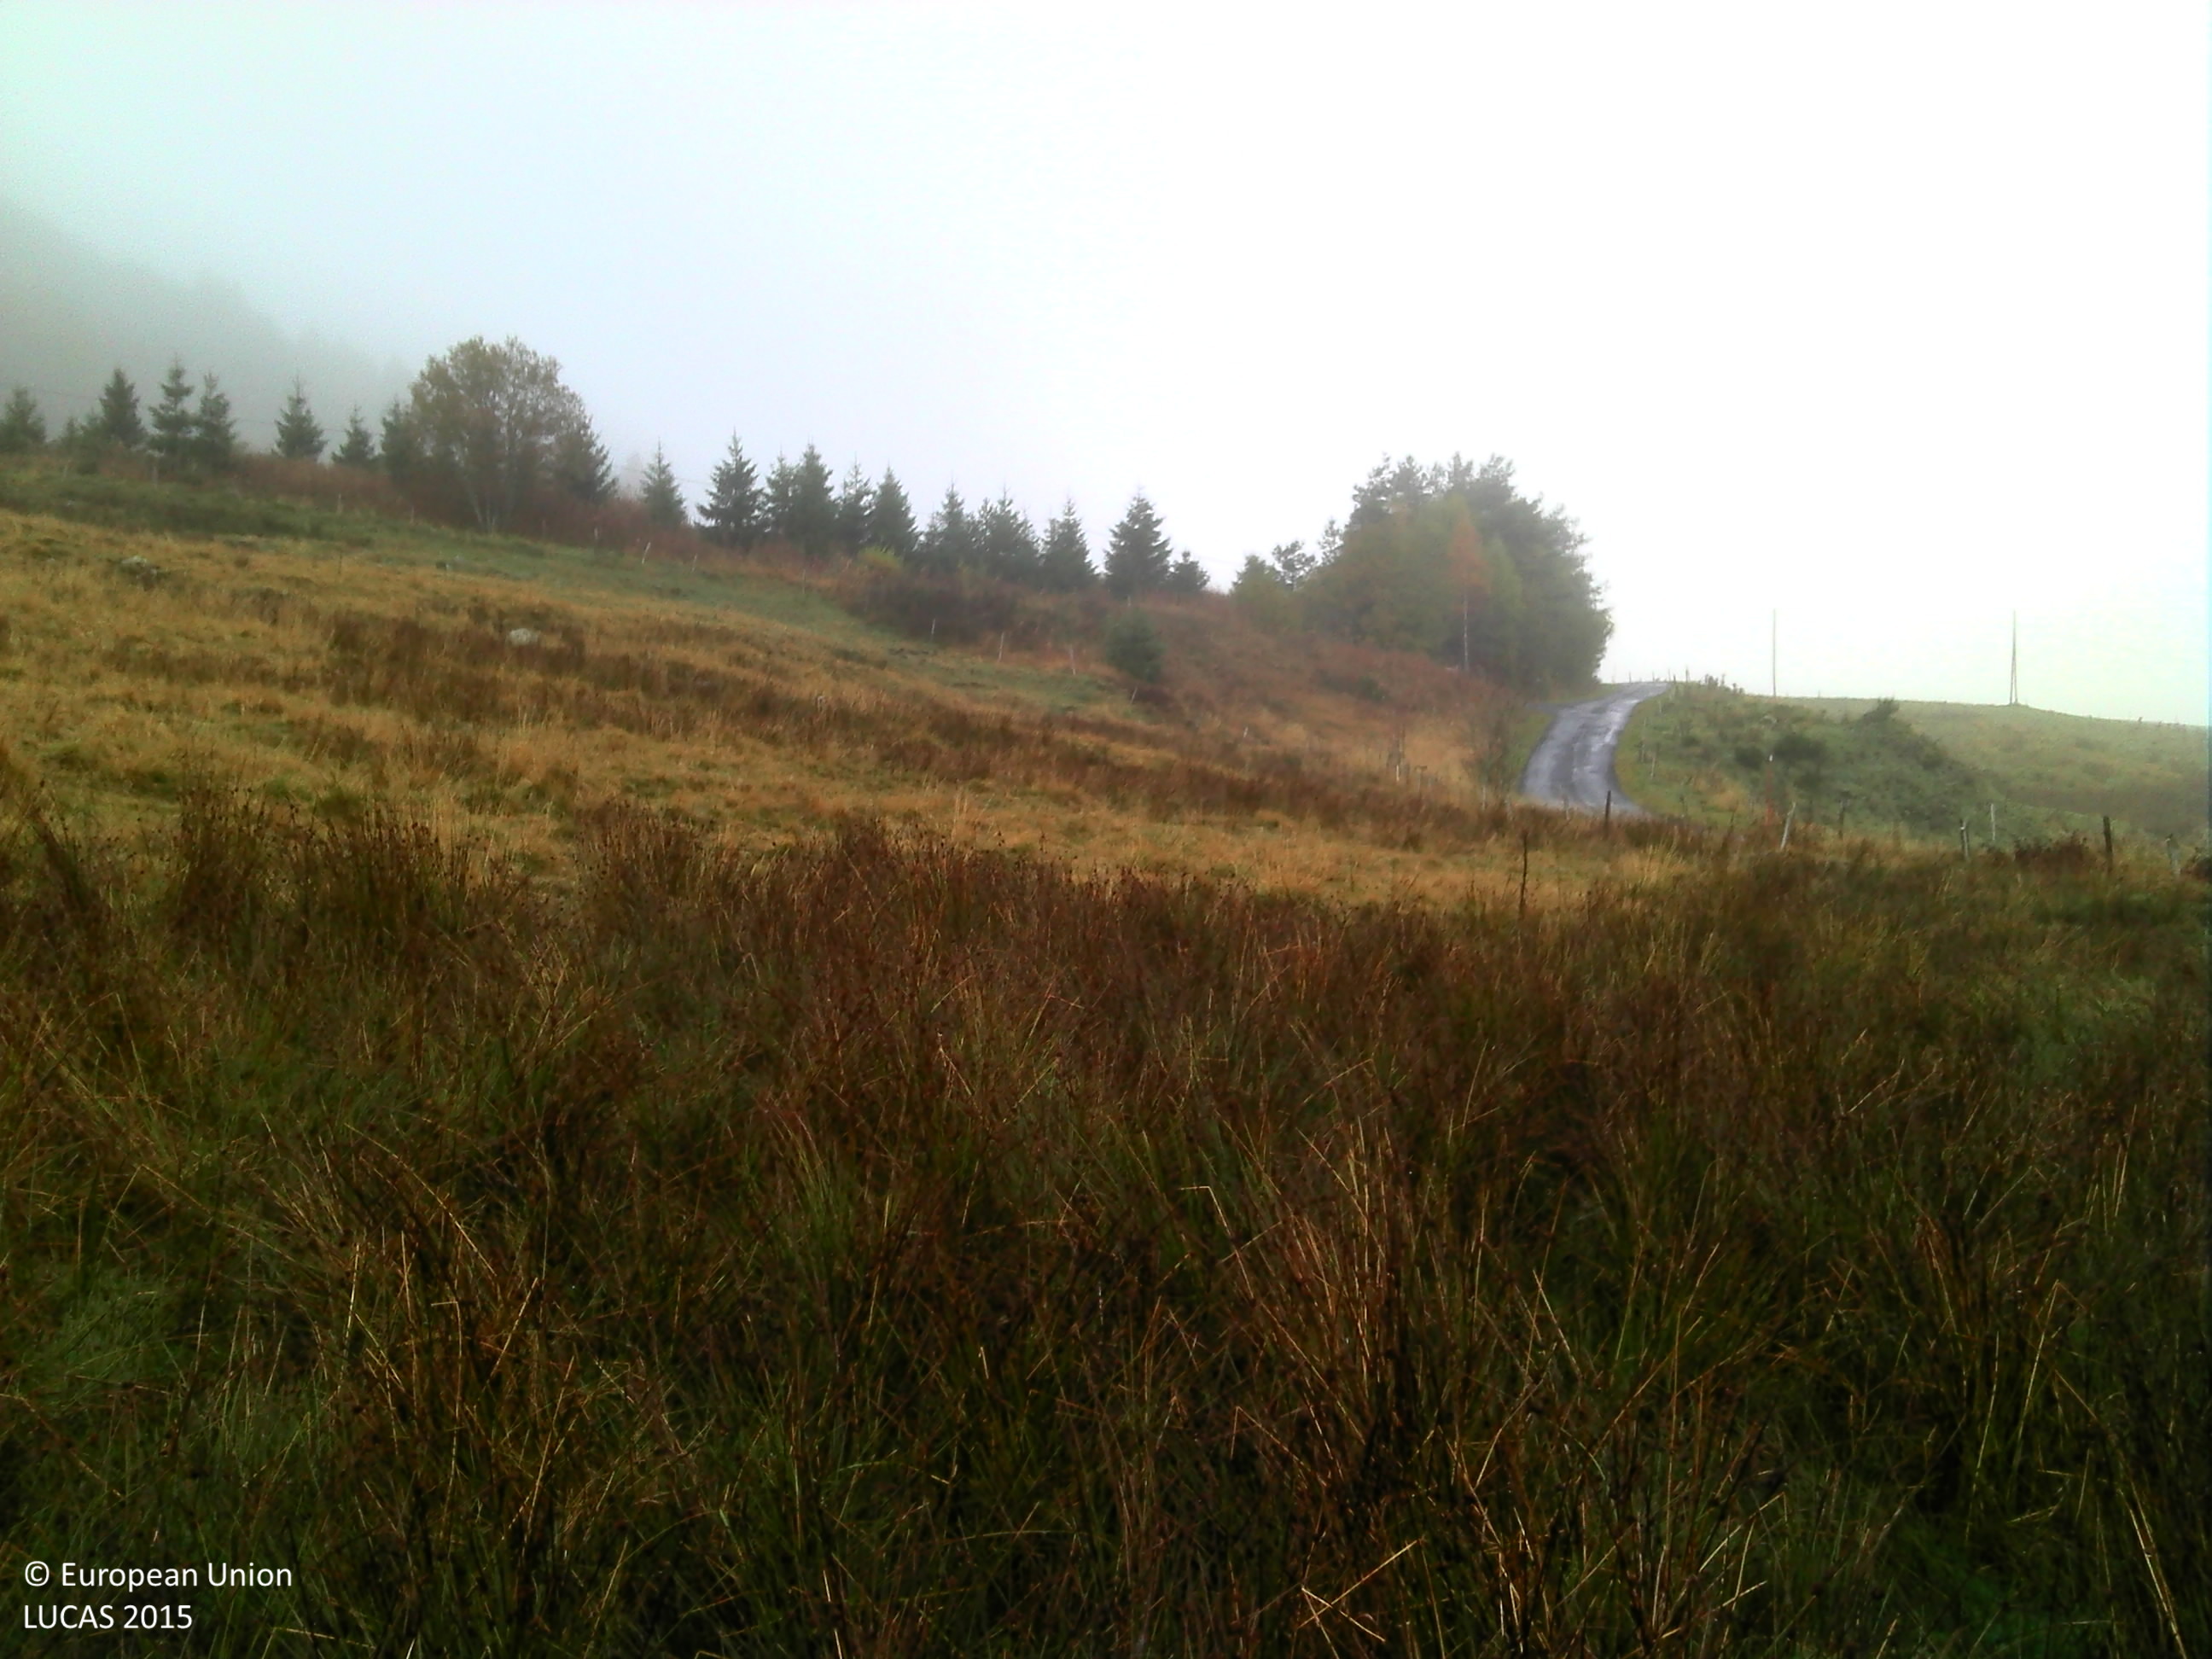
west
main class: Grassland
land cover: Grassland without tree/shrub cover
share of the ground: > 75 %
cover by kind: herbaceous plants 100 %
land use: Agriculture (excluding fallow land and kitchen gardens)
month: October
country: FR
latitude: 44.9468
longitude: 4.1875
